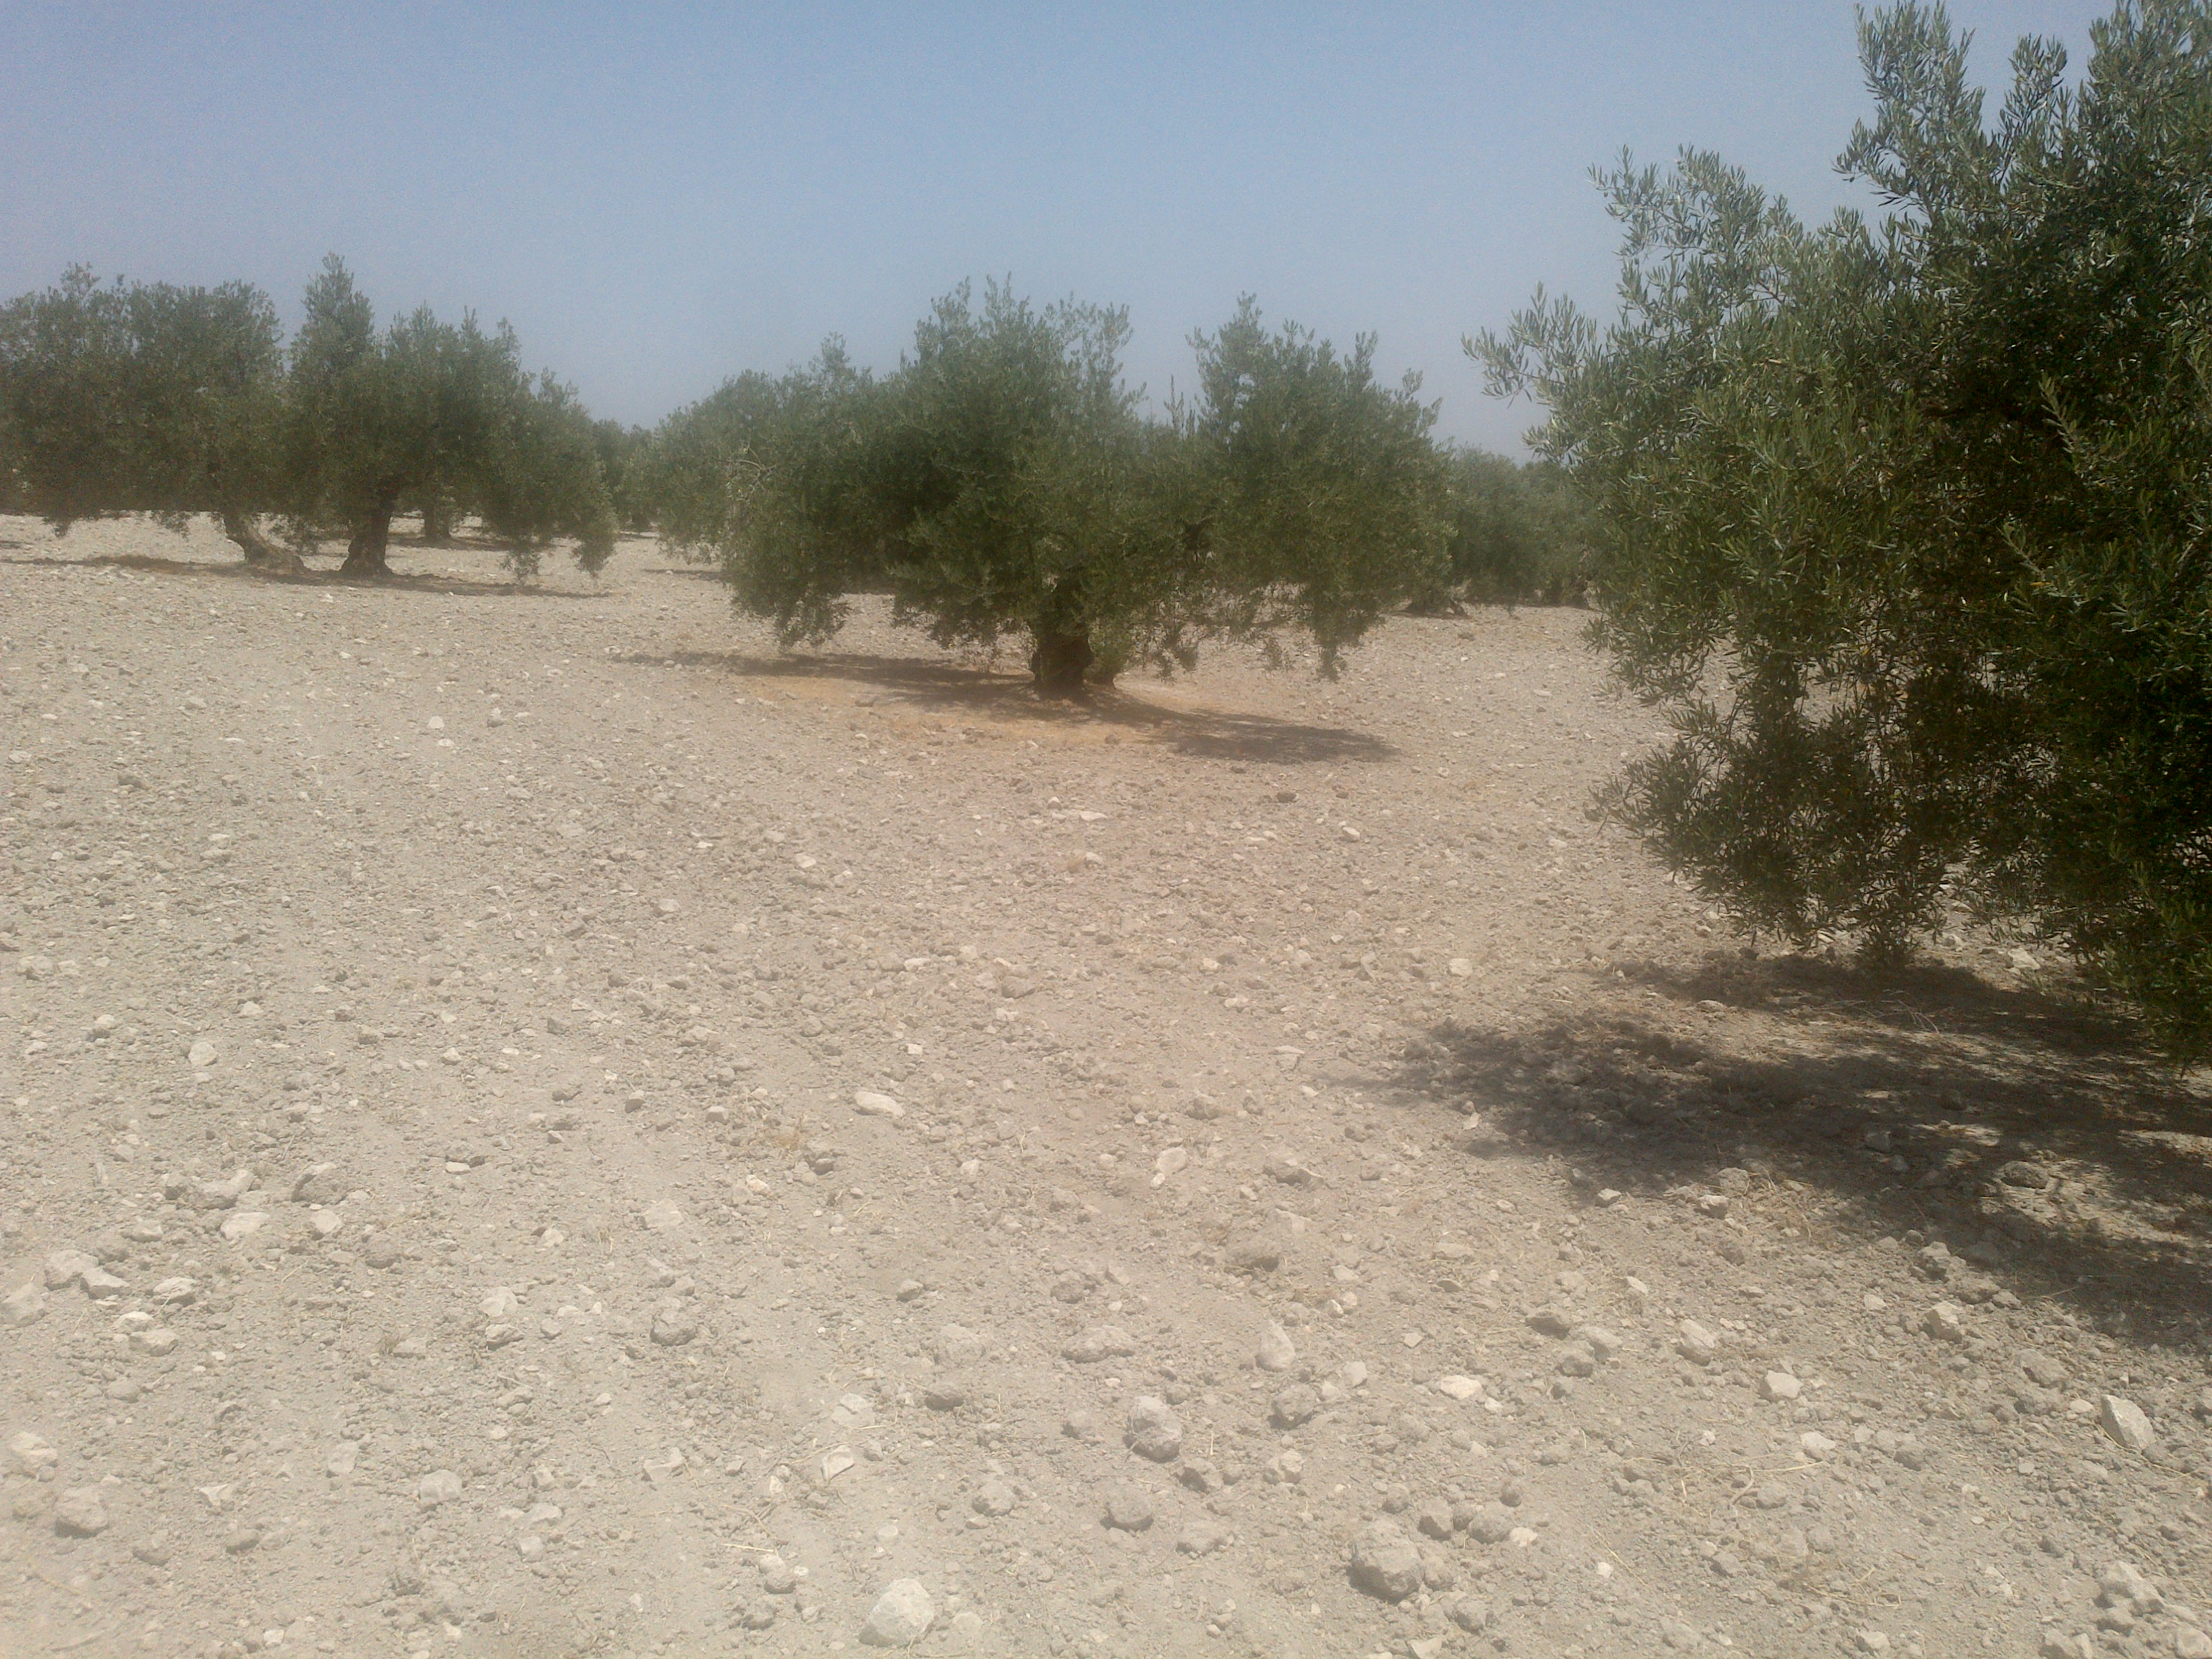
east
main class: Cropland
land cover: Olive groves
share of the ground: 25 - 50 %
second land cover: Other bare soil
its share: > 75 %
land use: Agriculture (excluding fallow land and kitchen gardens)
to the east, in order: Olive groves; Other bare soil
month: June
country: ES
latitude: 37.6036
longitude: -4.2642
